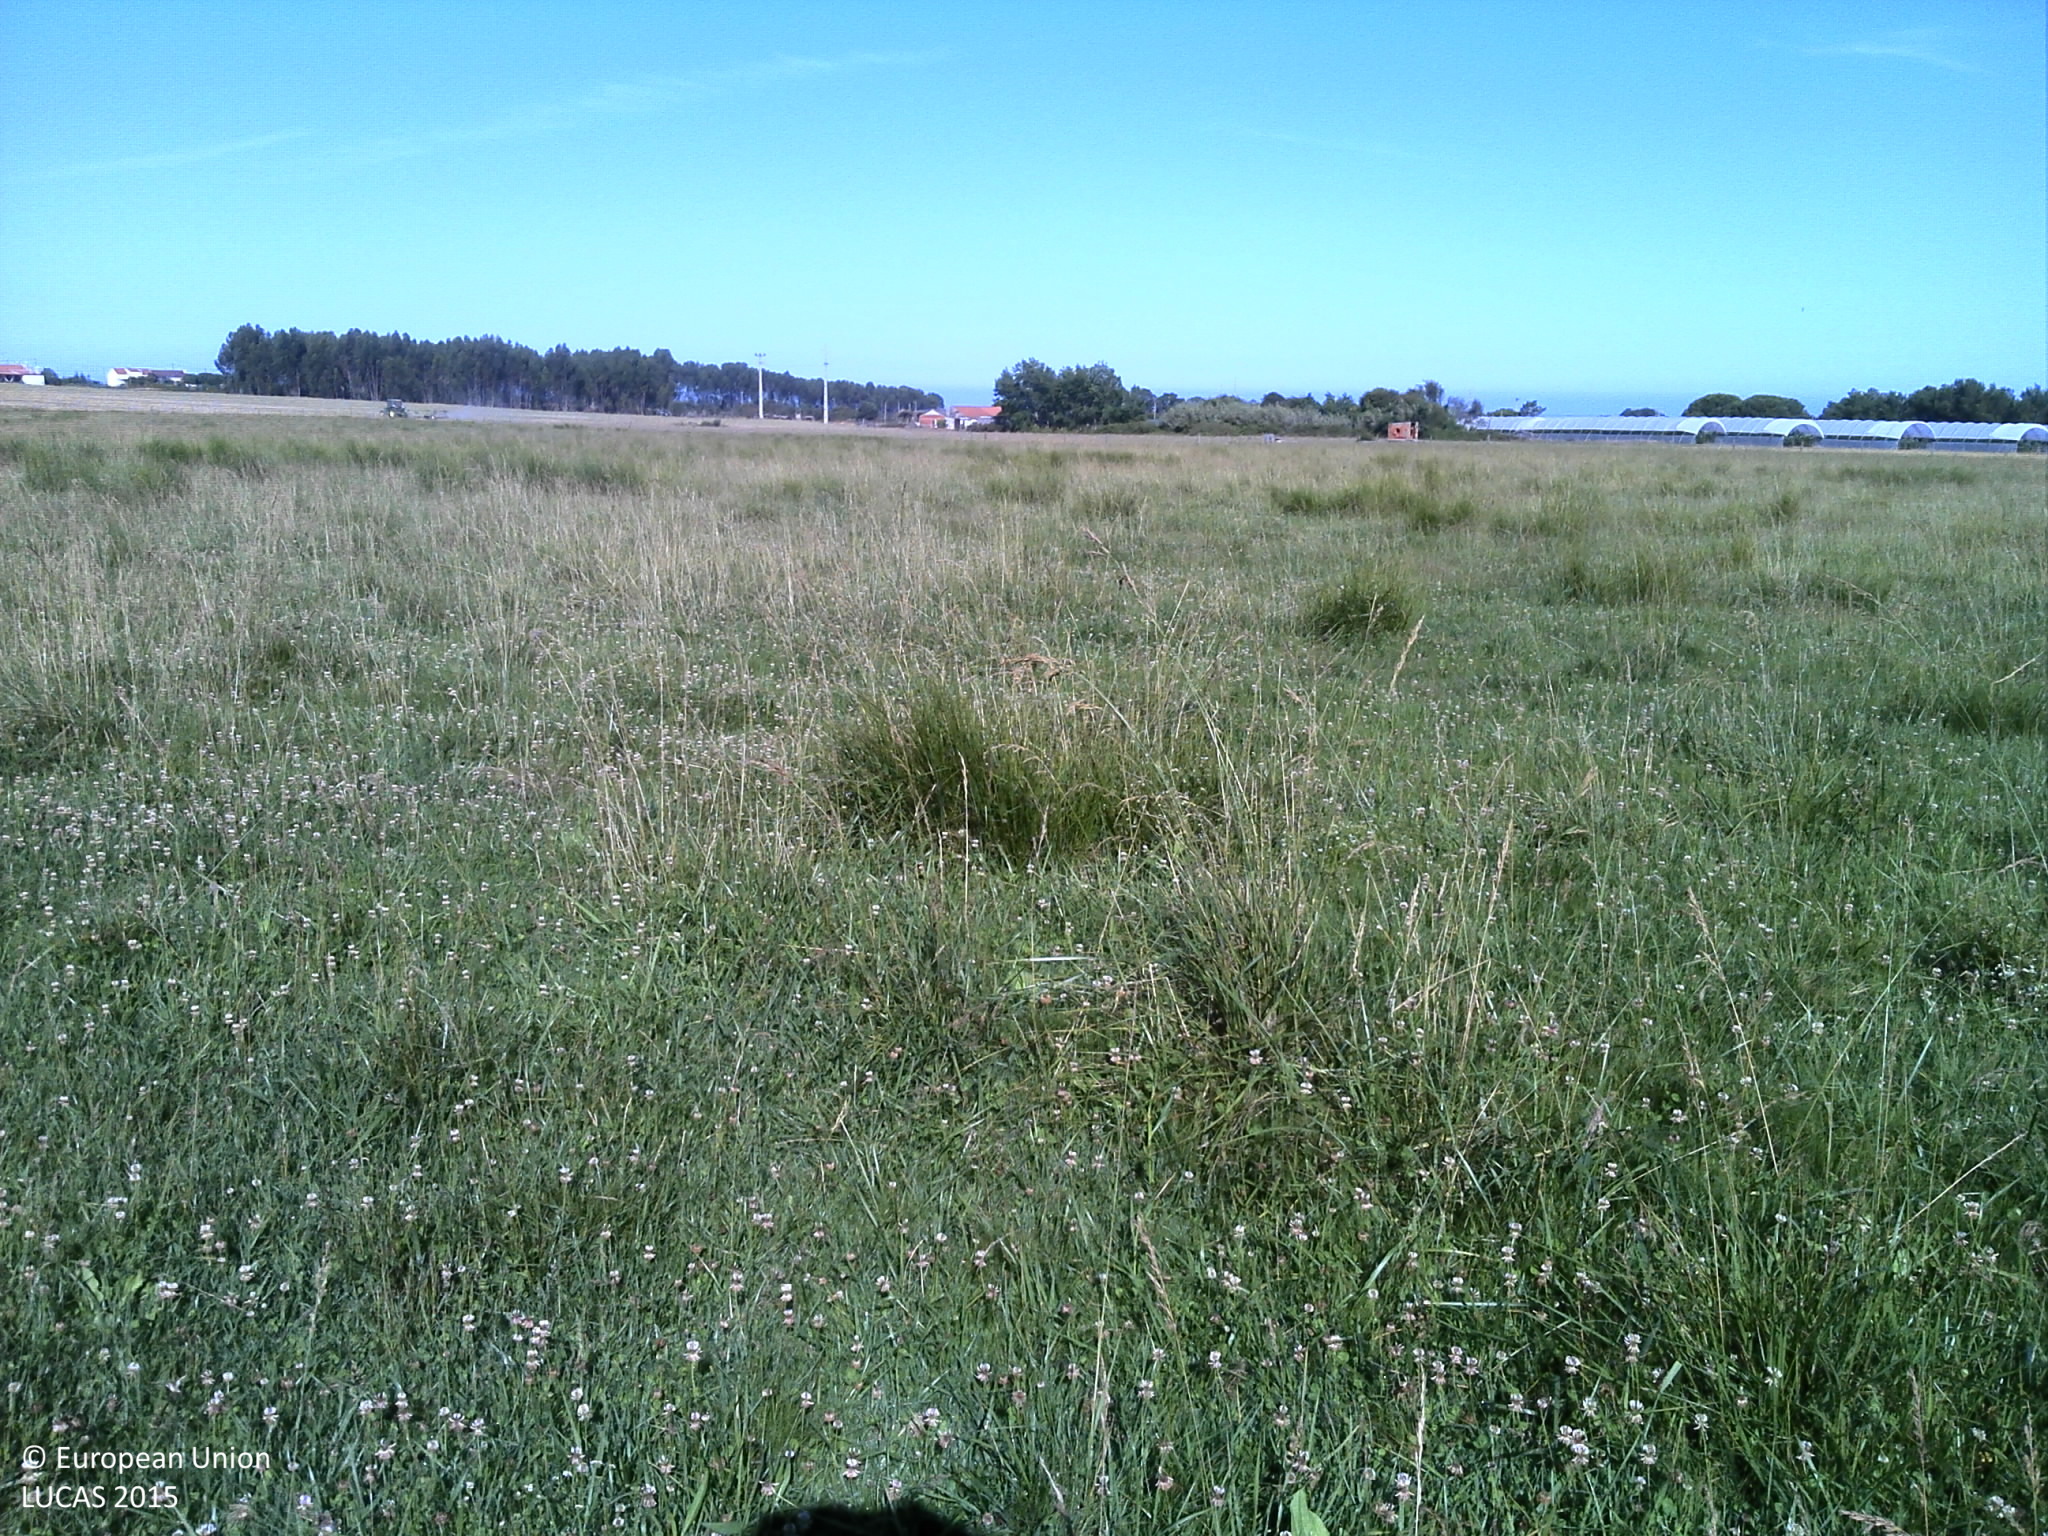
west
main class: Cropland
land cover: Temporary grasslands
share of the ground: > 75 %
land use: Agriculture (excluding fallow land and kitchen gardens)
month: June
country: PT
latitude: 37.4772
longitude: -8.7533
